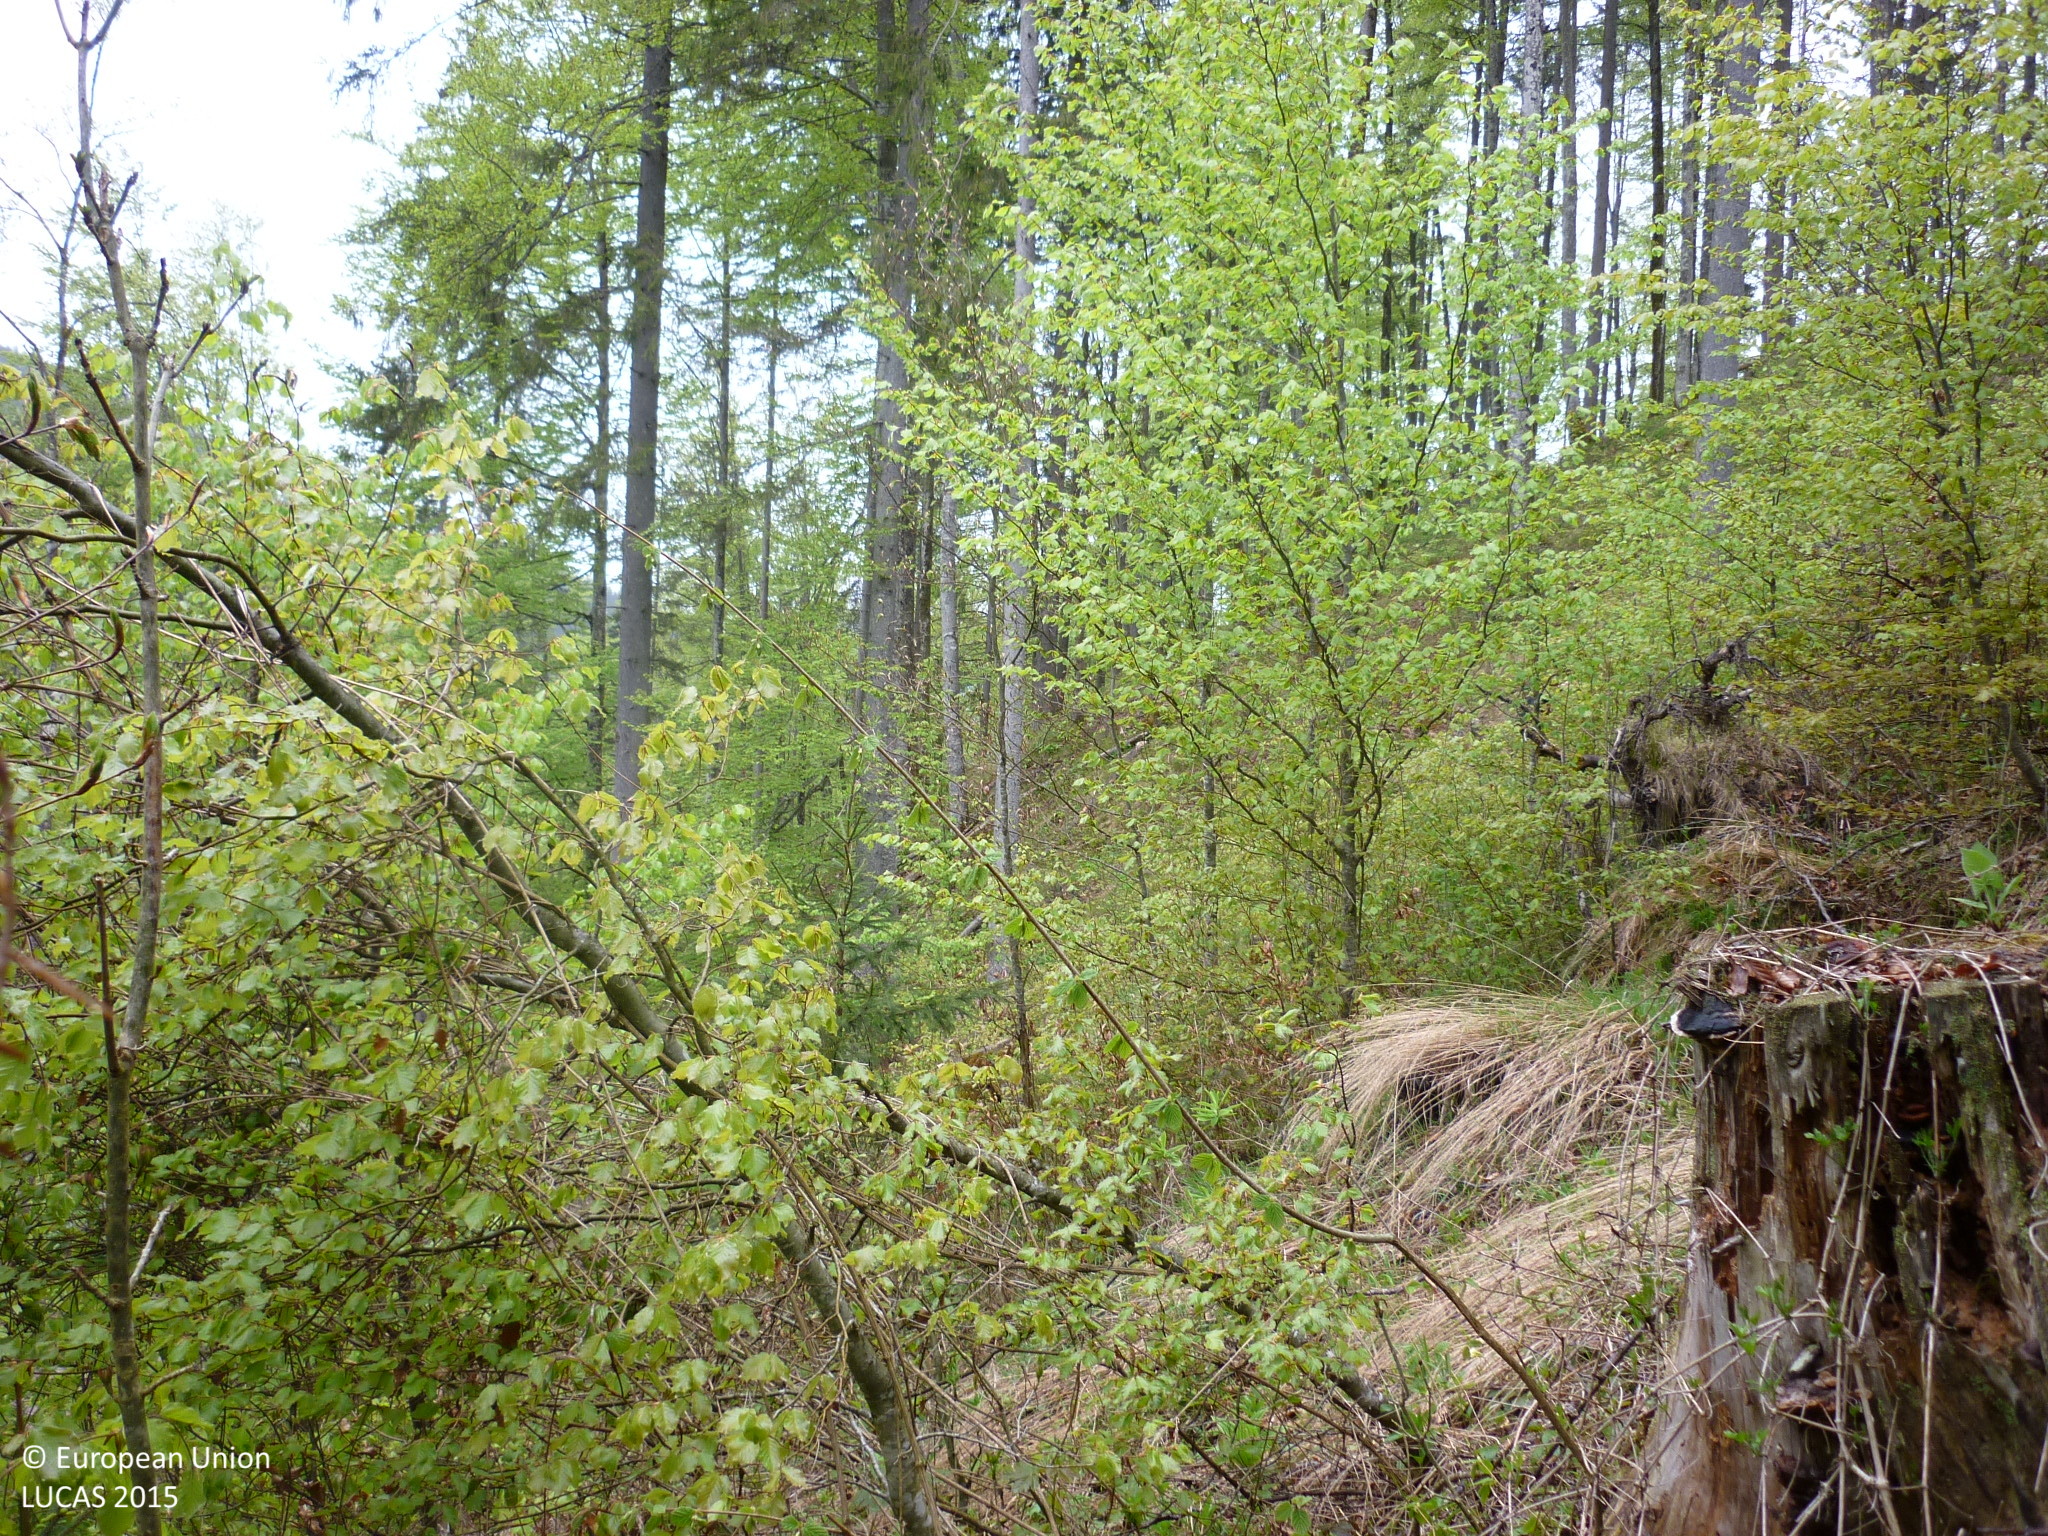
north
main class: Woodland
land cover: Broadleaved woodland
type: mountainous beech forest
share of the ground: > 75 %
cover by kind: broadleaved forest trees 90 %, coniferous forest trees 5 %, herbaceous plants 5 %
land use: Forestry
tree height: < 5 m
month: May
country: AT
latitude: 47.6917
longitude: 14.6763
